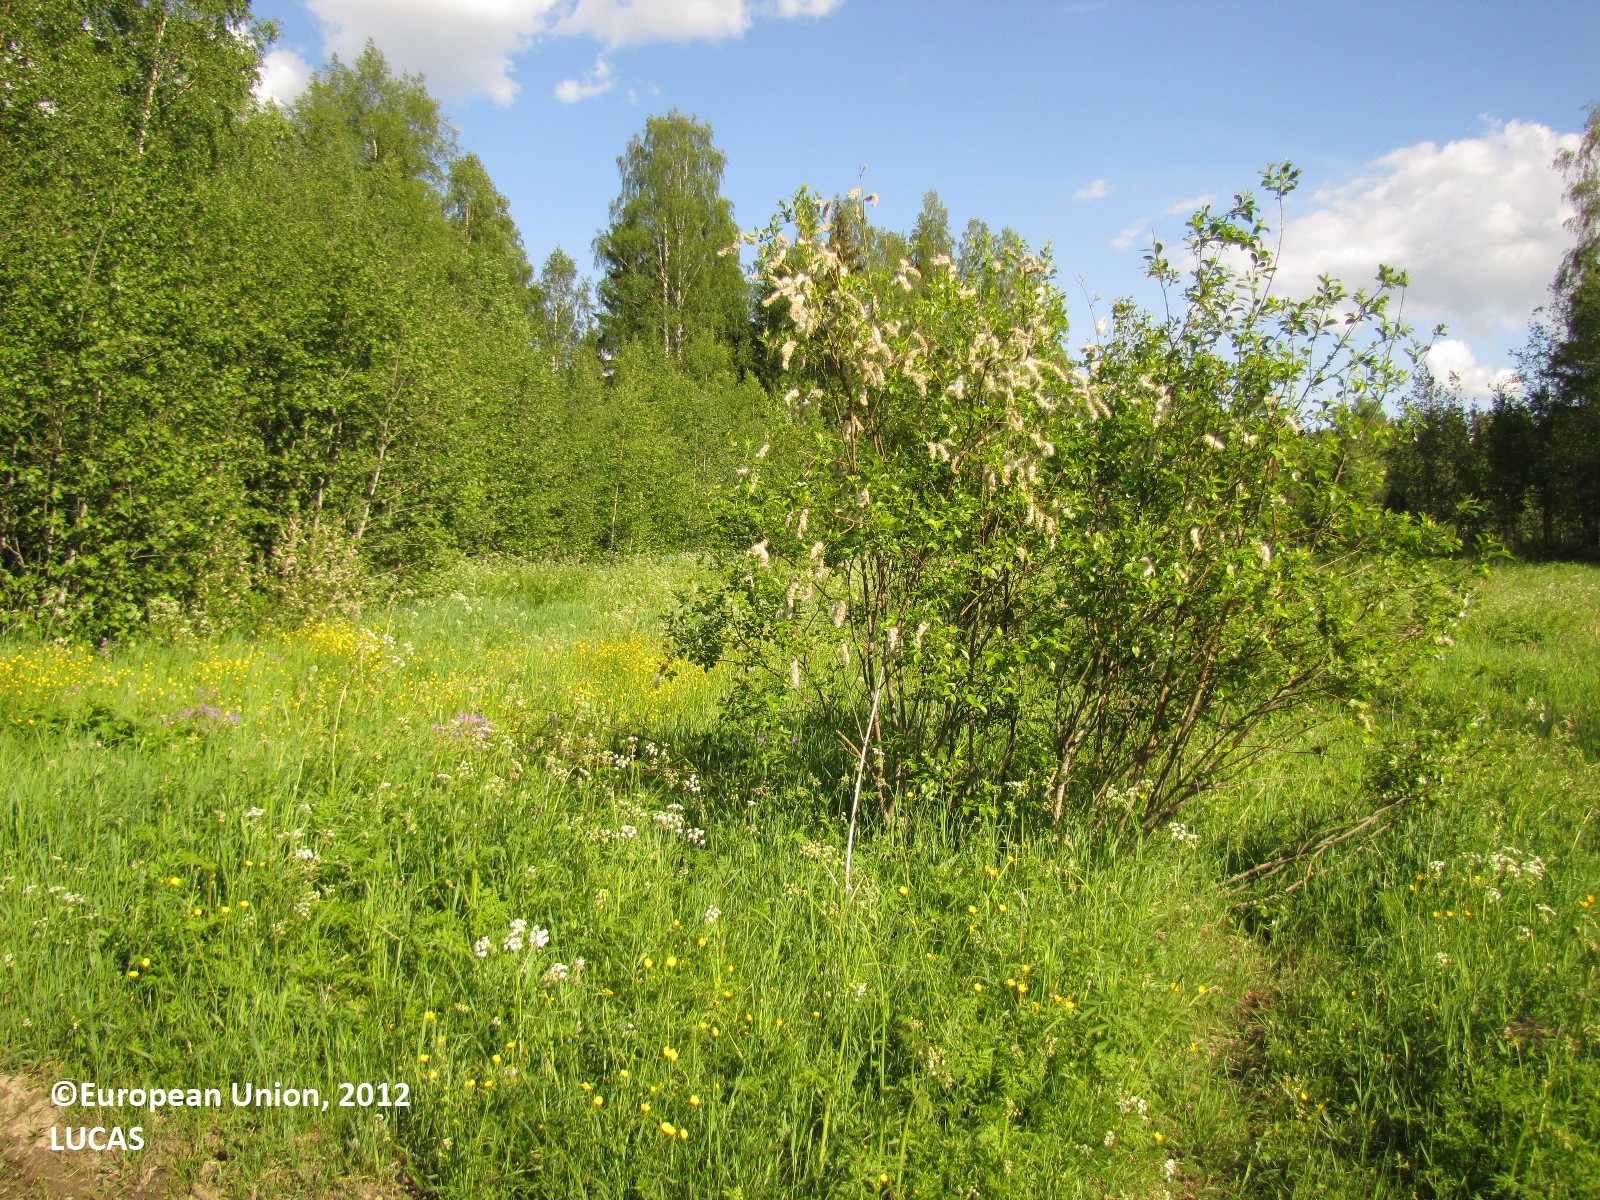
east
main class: Cropland
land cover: Barley
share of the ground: < 10 %
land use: Agriculture (excluding fallow land and kitchen gardens)
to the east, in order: Barley; Tracks; Broadleaved woodland
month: June
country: FI
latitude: 61.2625
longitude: 22.9556
